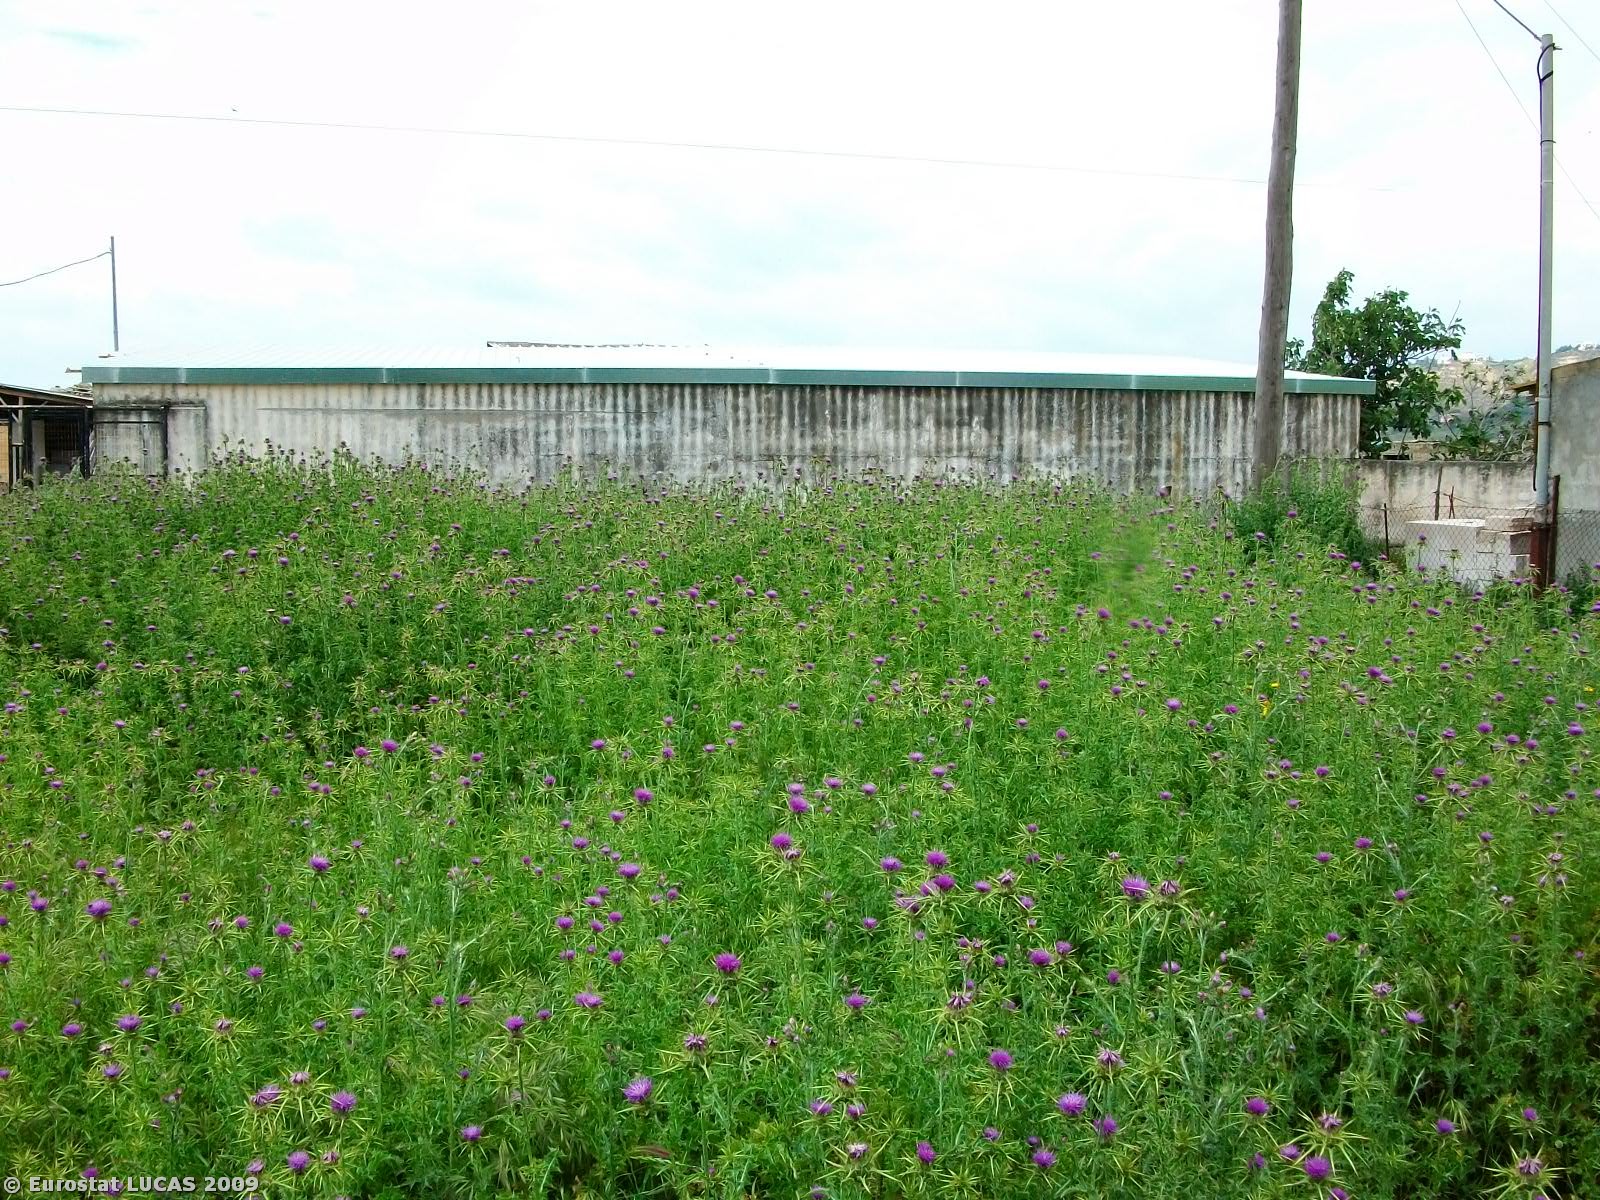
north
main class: Grassland
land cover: Spontaneously vegetated surfaces
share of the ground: 50 - 75 %
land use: Unused
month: May
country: GR
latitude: 35.2797
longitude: 25.1091
